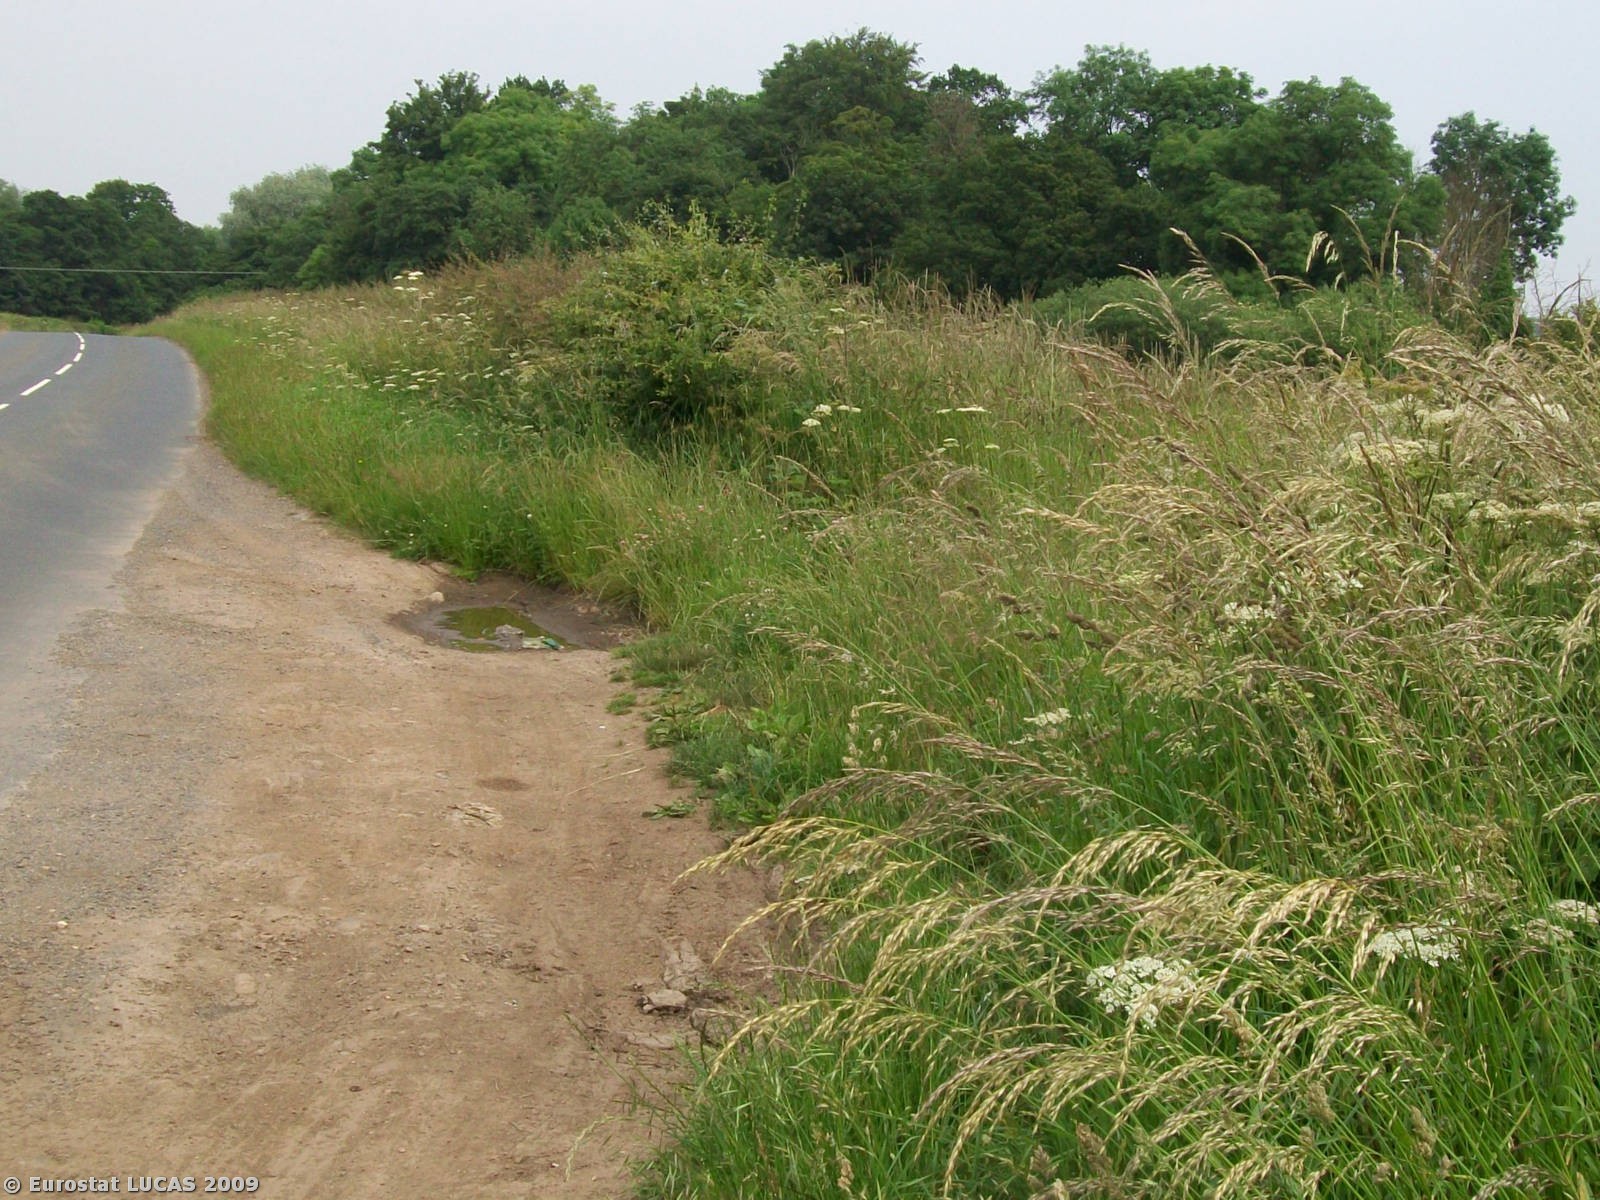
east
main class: Artificial land
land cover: Non built-up linear features
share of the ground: > 75 %
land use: Road transport
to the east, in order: Non built-up linear features; Grassland without tree/shrub cover; Ditches and canals; Abandoned hedges; Grass margins; Barley
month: June
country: GB
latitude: 54.0549
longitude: -1.4597
